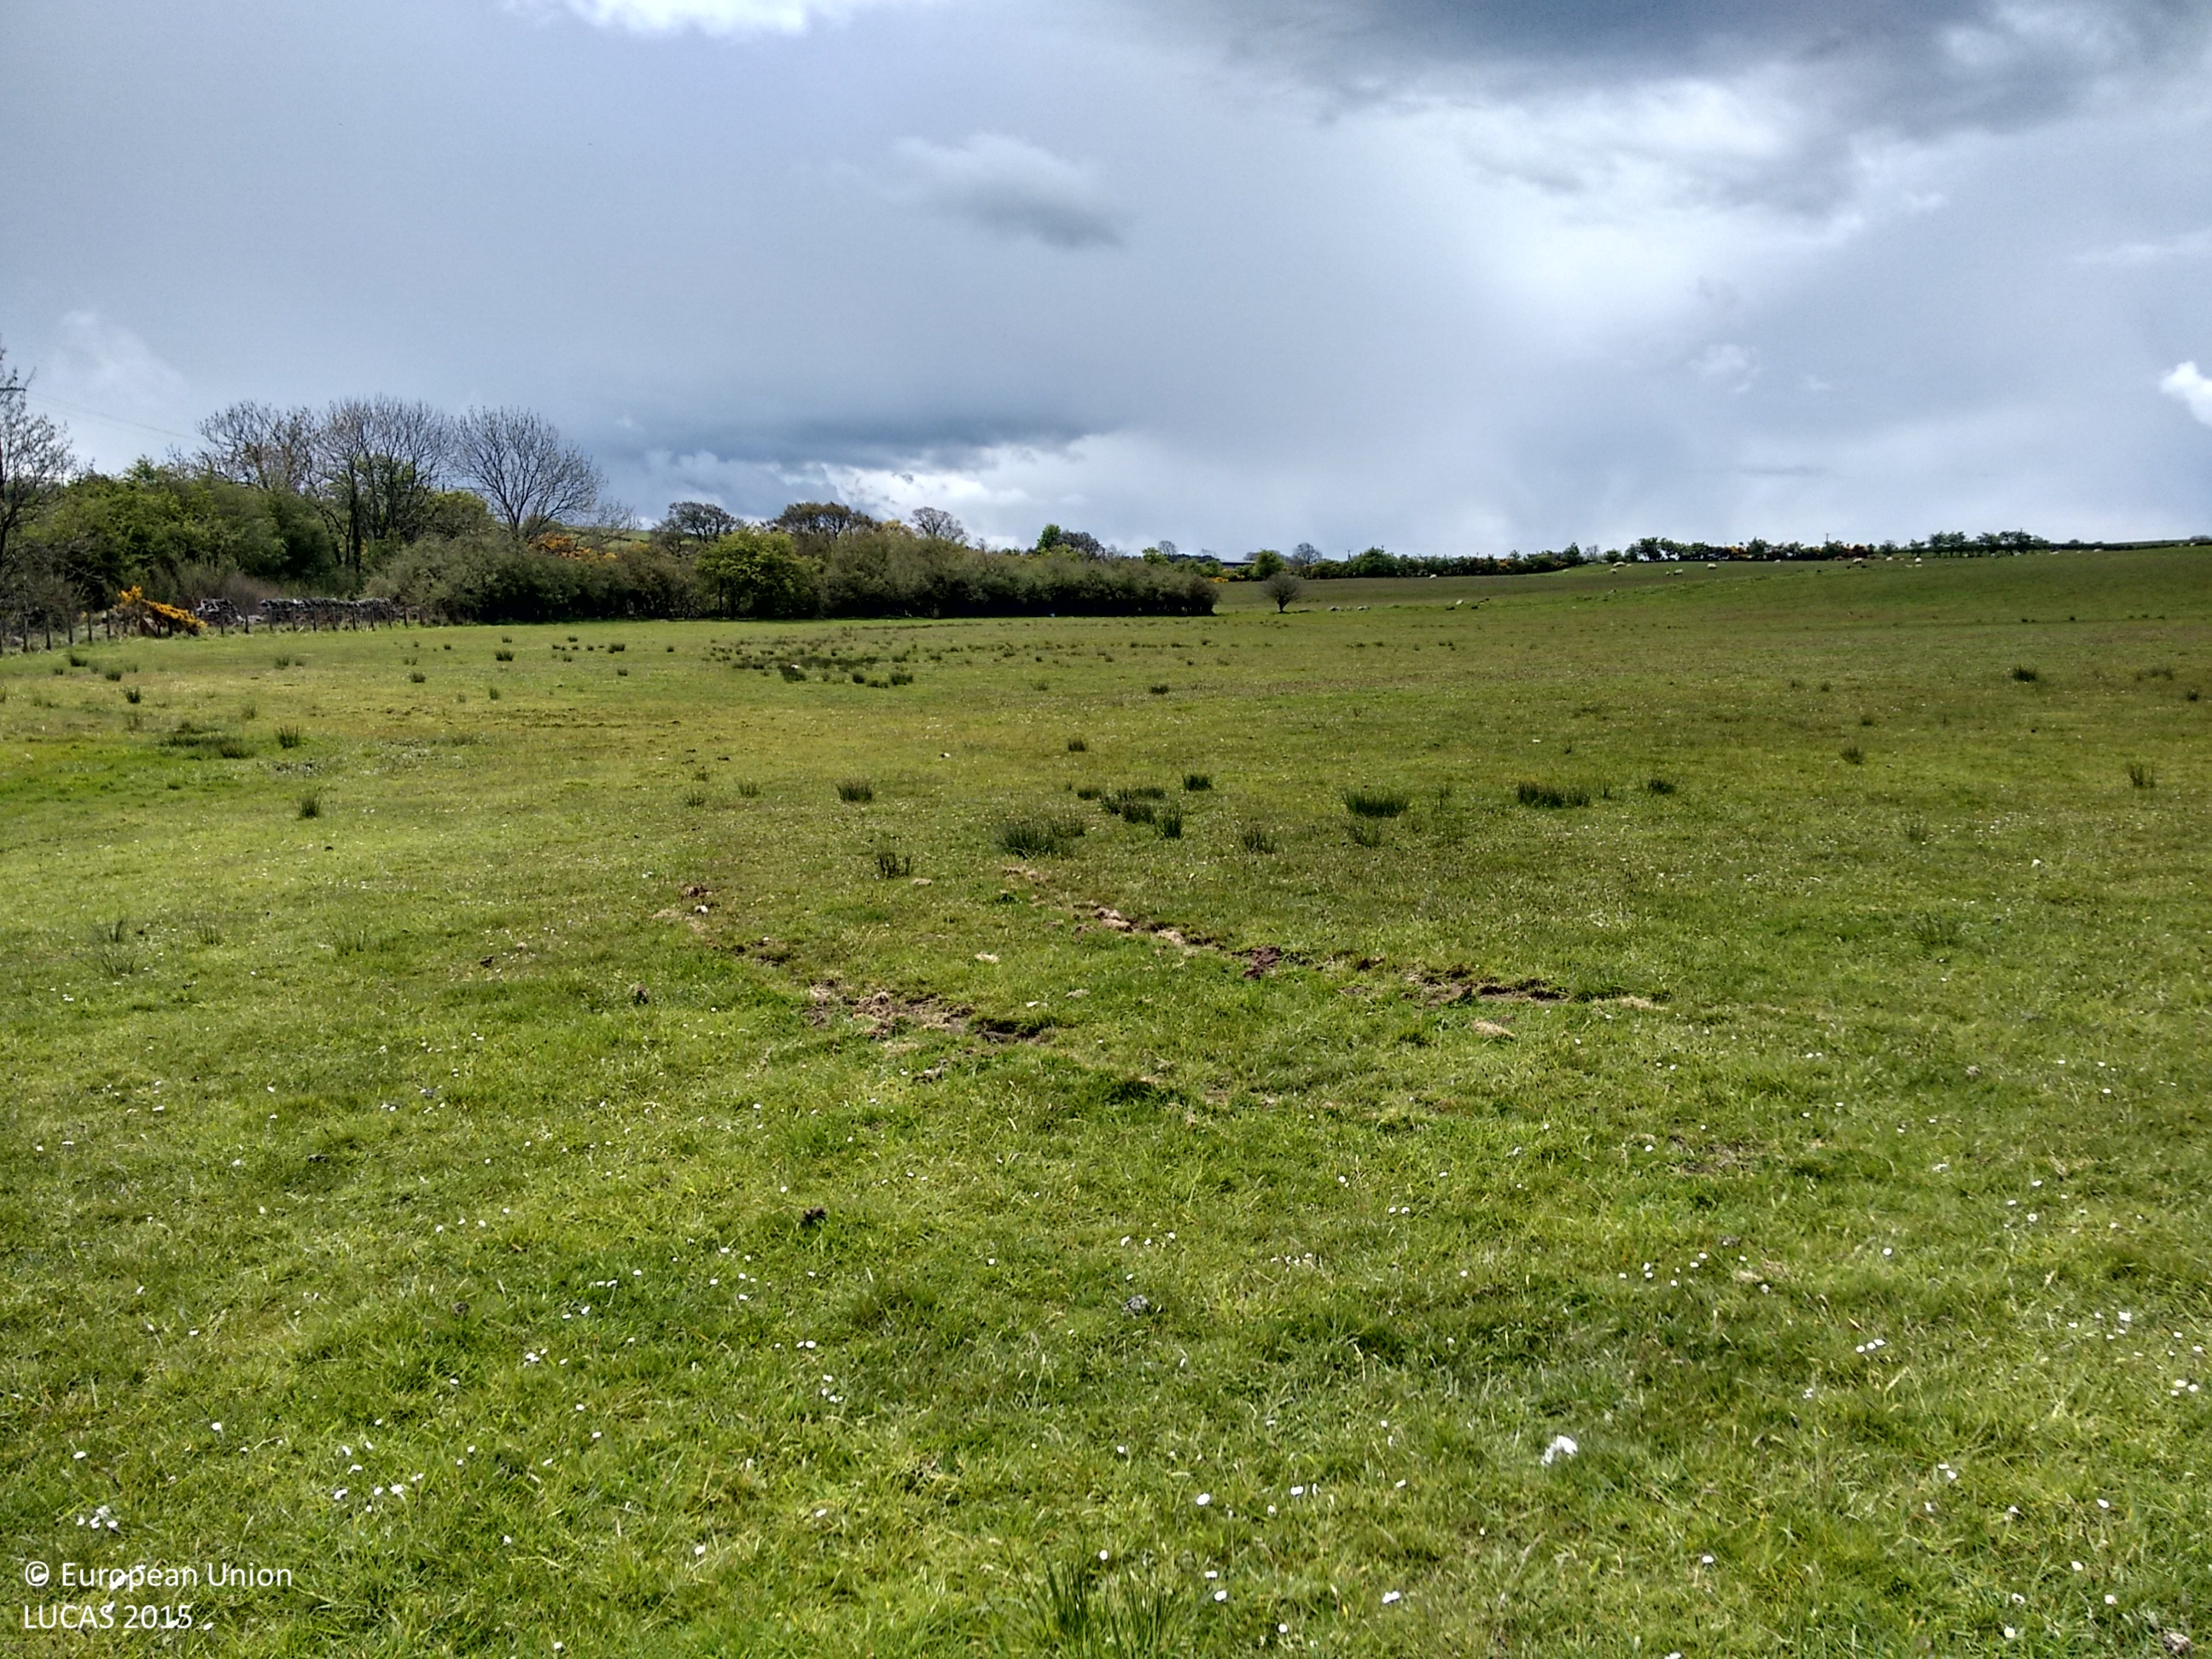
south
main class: Grassland
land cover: Grassland without tree/shrub cover
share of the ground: > 75 %
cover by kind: herbaceous plants 100 %
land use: Agriculture (excluding fallow land and kitchen gardens)
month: May
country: GB
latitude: 55.3913
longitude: -1.7480
